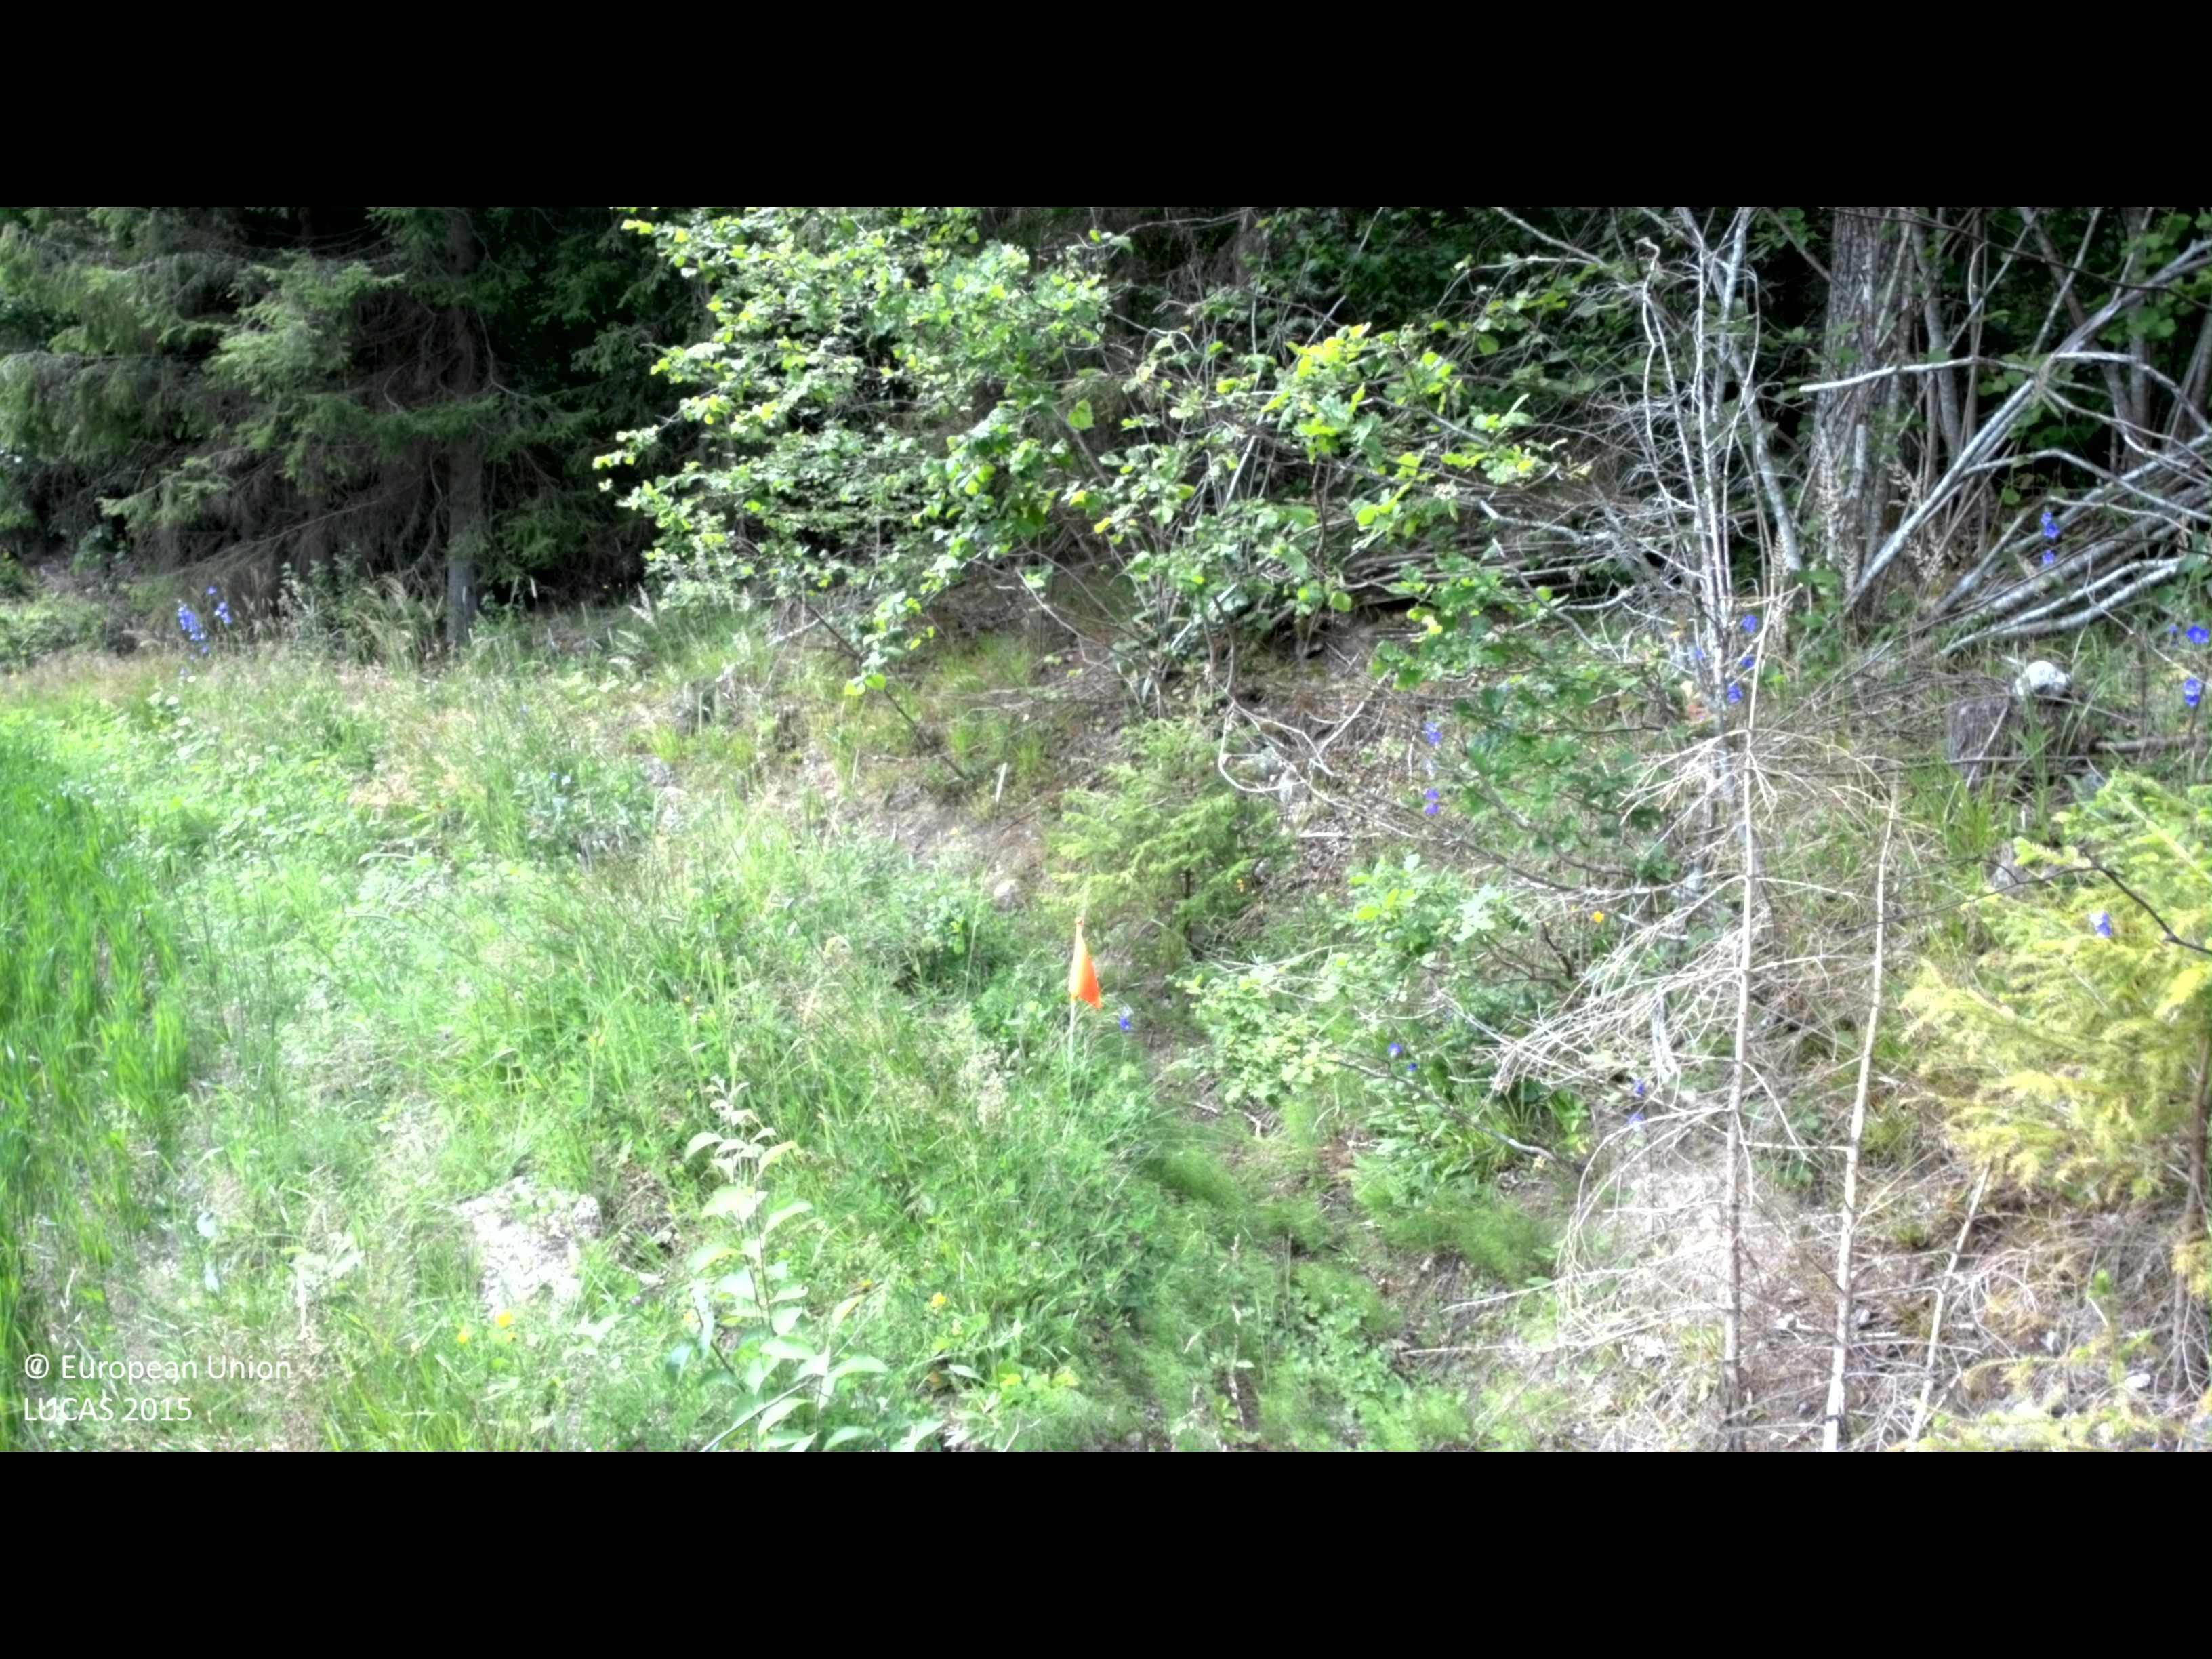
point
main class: Woodland
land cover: Other mixed woodland
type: boreal forest
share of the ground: > 75 %
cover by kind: coniferous forest trees 50 %, broadleaved forest trees 30 %, shrubs 15 %, herbaceous plants 5 %
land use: Forestry
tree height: > 5 m
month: July
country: SE
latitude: 58.2905
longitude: 16.6326
